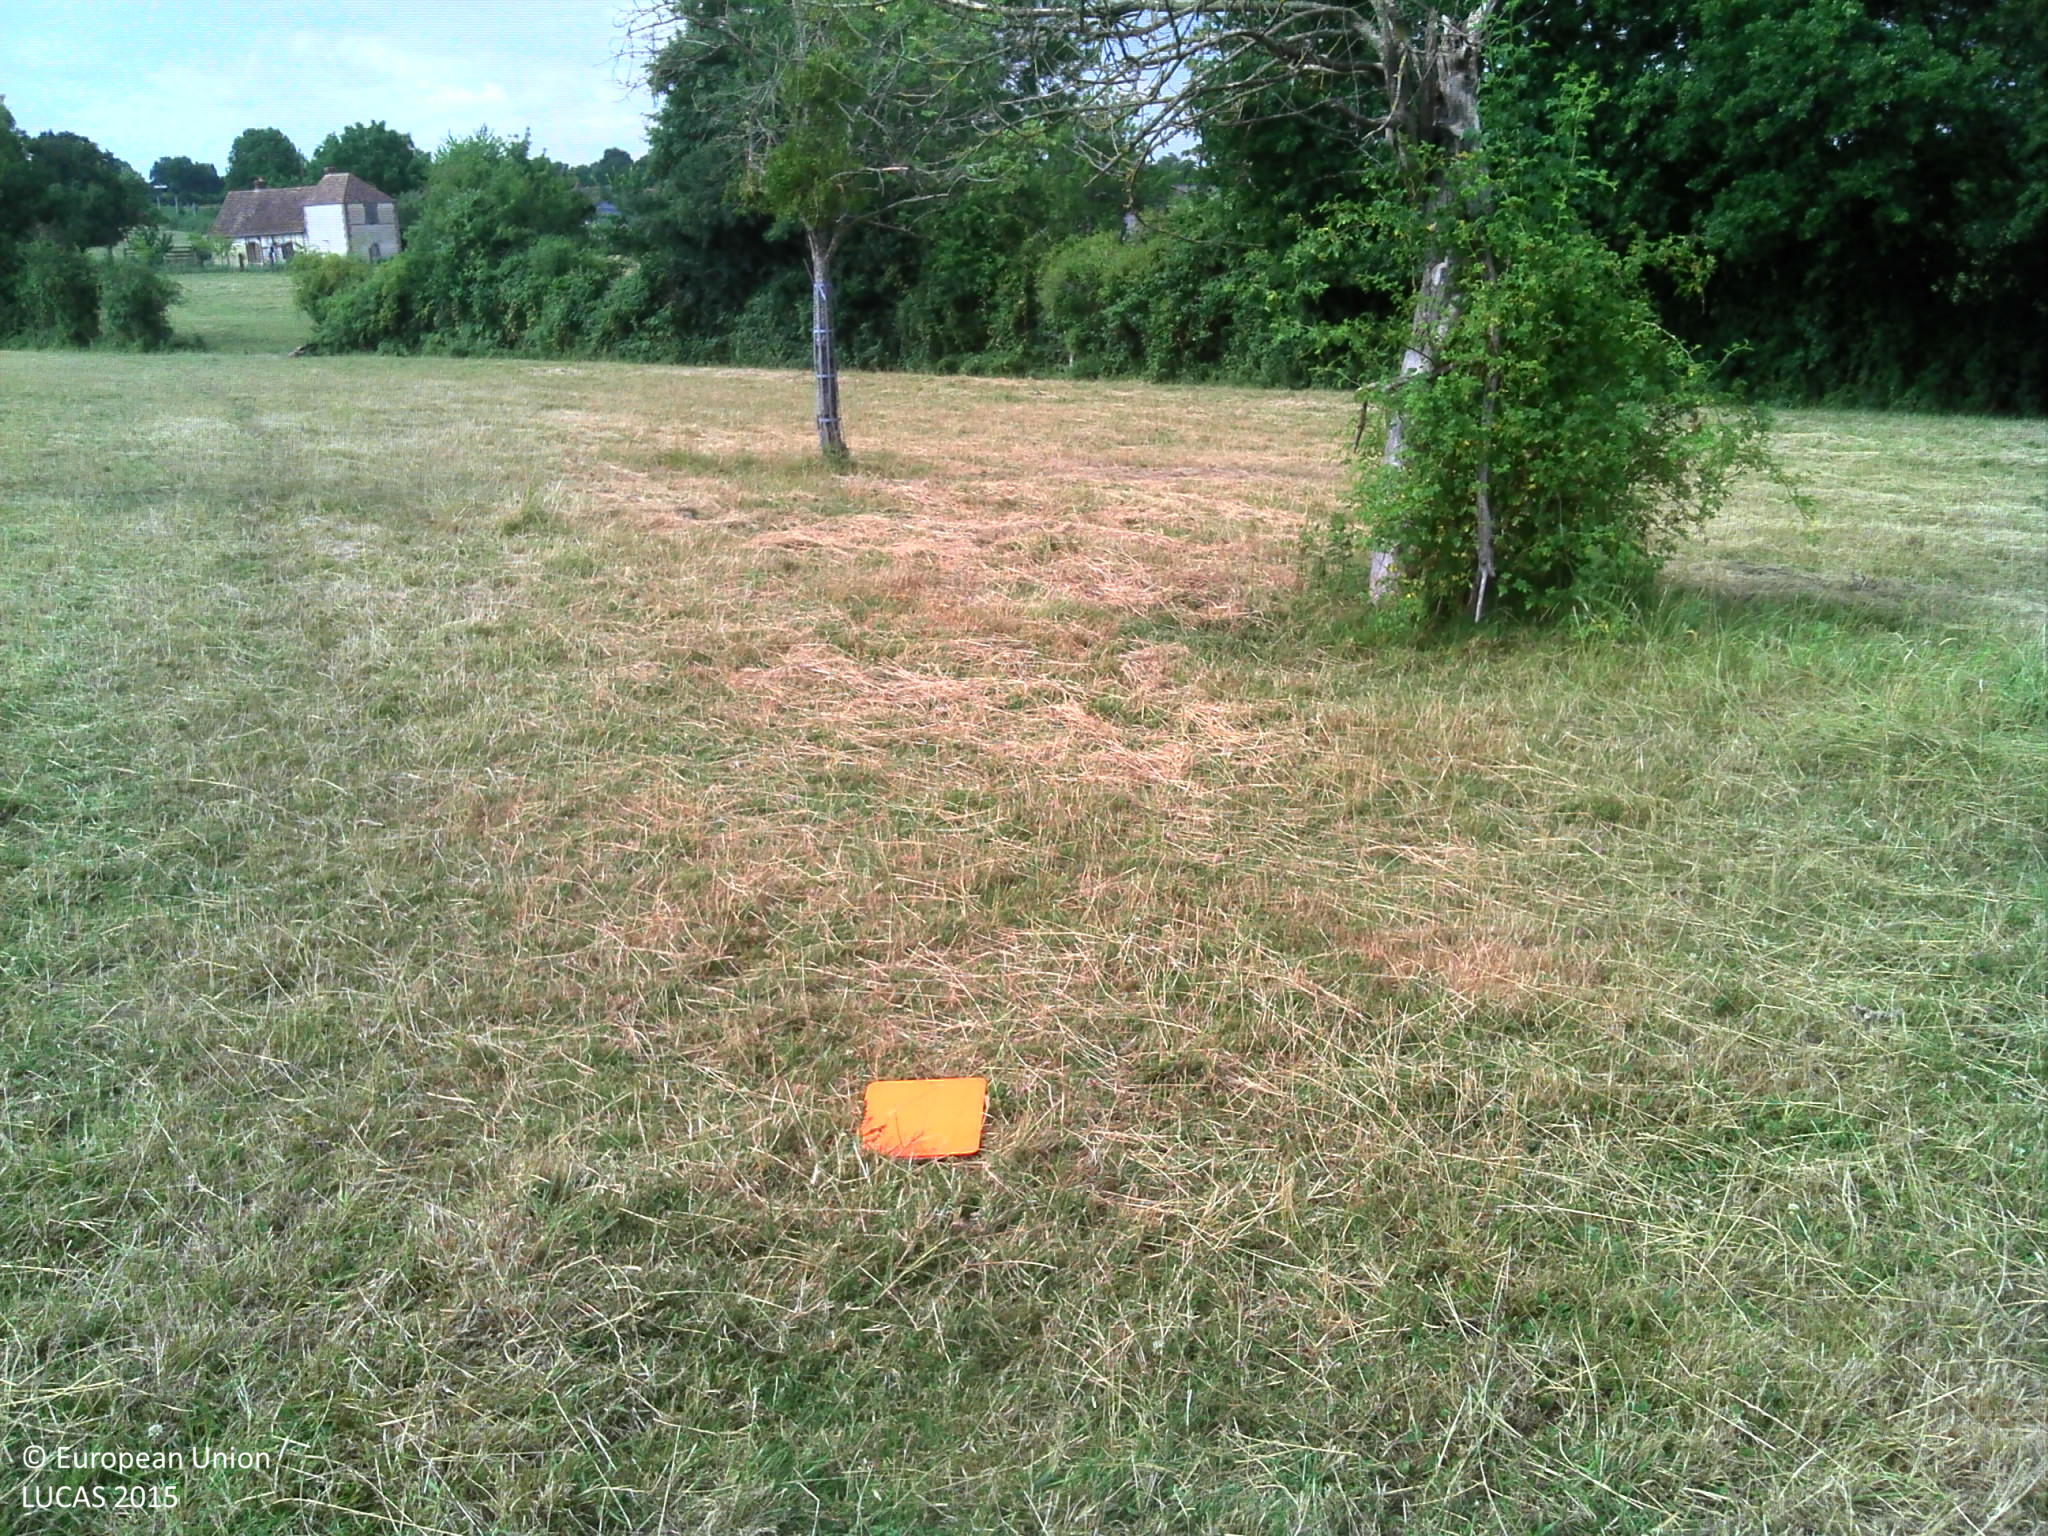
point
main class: Cropland
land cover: Apple fruit
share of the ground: 10 - 25 %
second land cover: Grassland without tree/shrub cover
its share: > 75 %
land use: Agriculture (excluding fallow land and kitchen gardens)
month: July
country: FR
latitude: 48.9499
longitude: 0.0425
